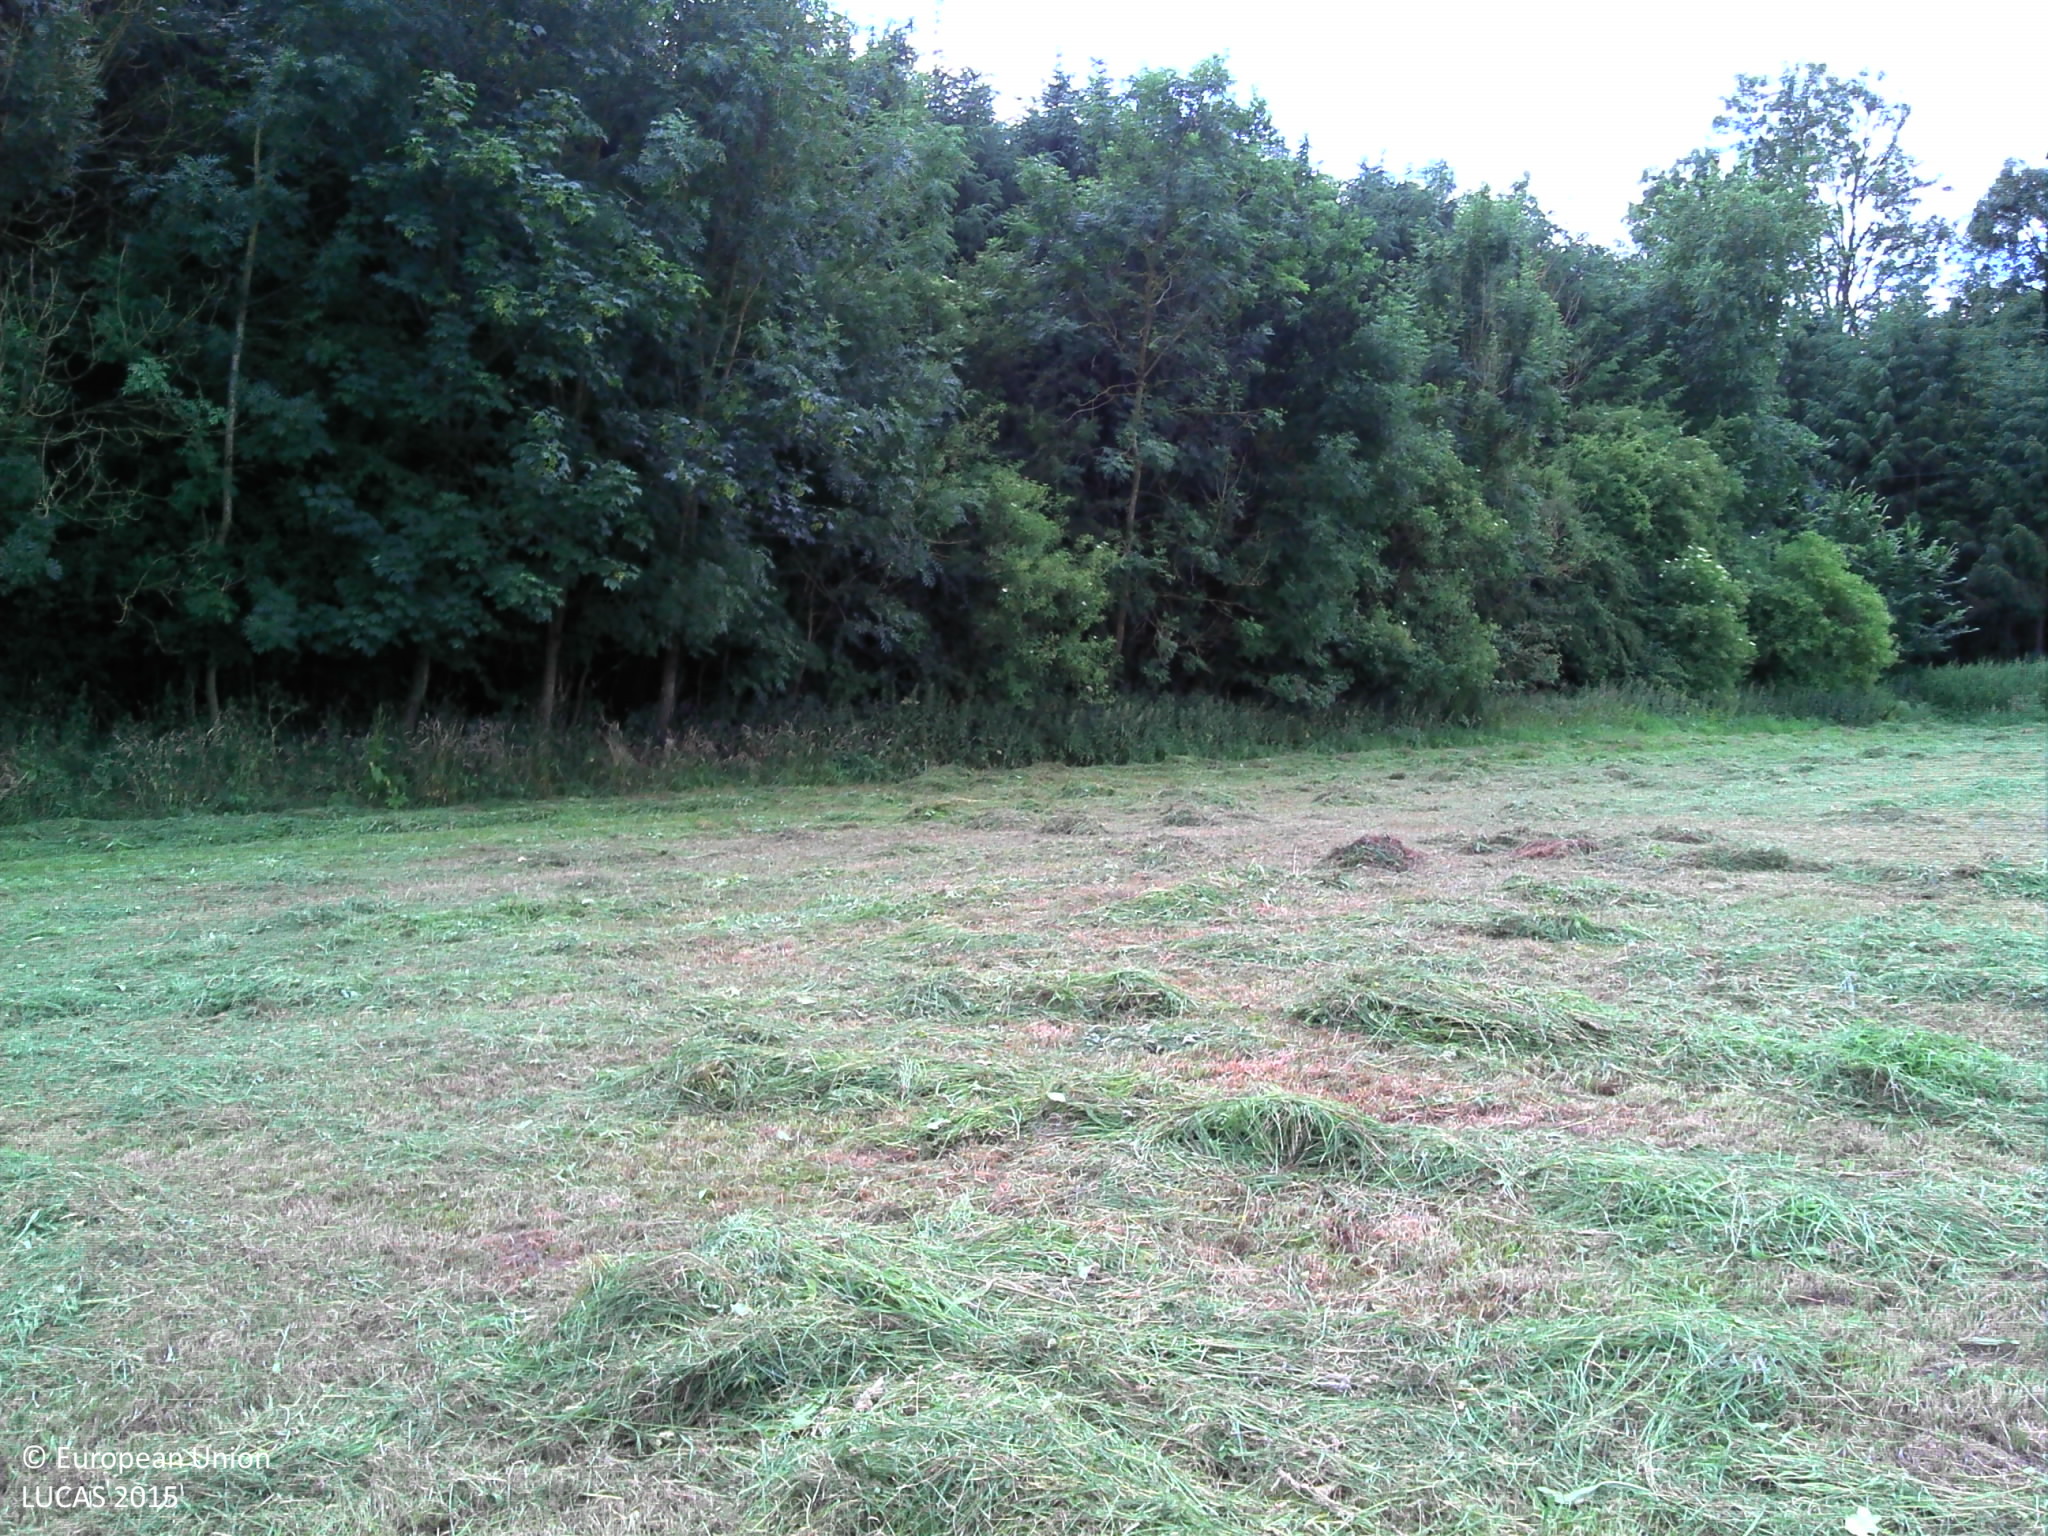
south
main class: Grassland
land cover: Grassland without tree/shrub cover
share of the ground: > 75 %
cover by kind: herbaceous plants 100 %
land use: Agriculture (excluding fallow land and kitchen gardens)
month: July
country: BE
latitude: 50.2557
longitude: 4.6243
